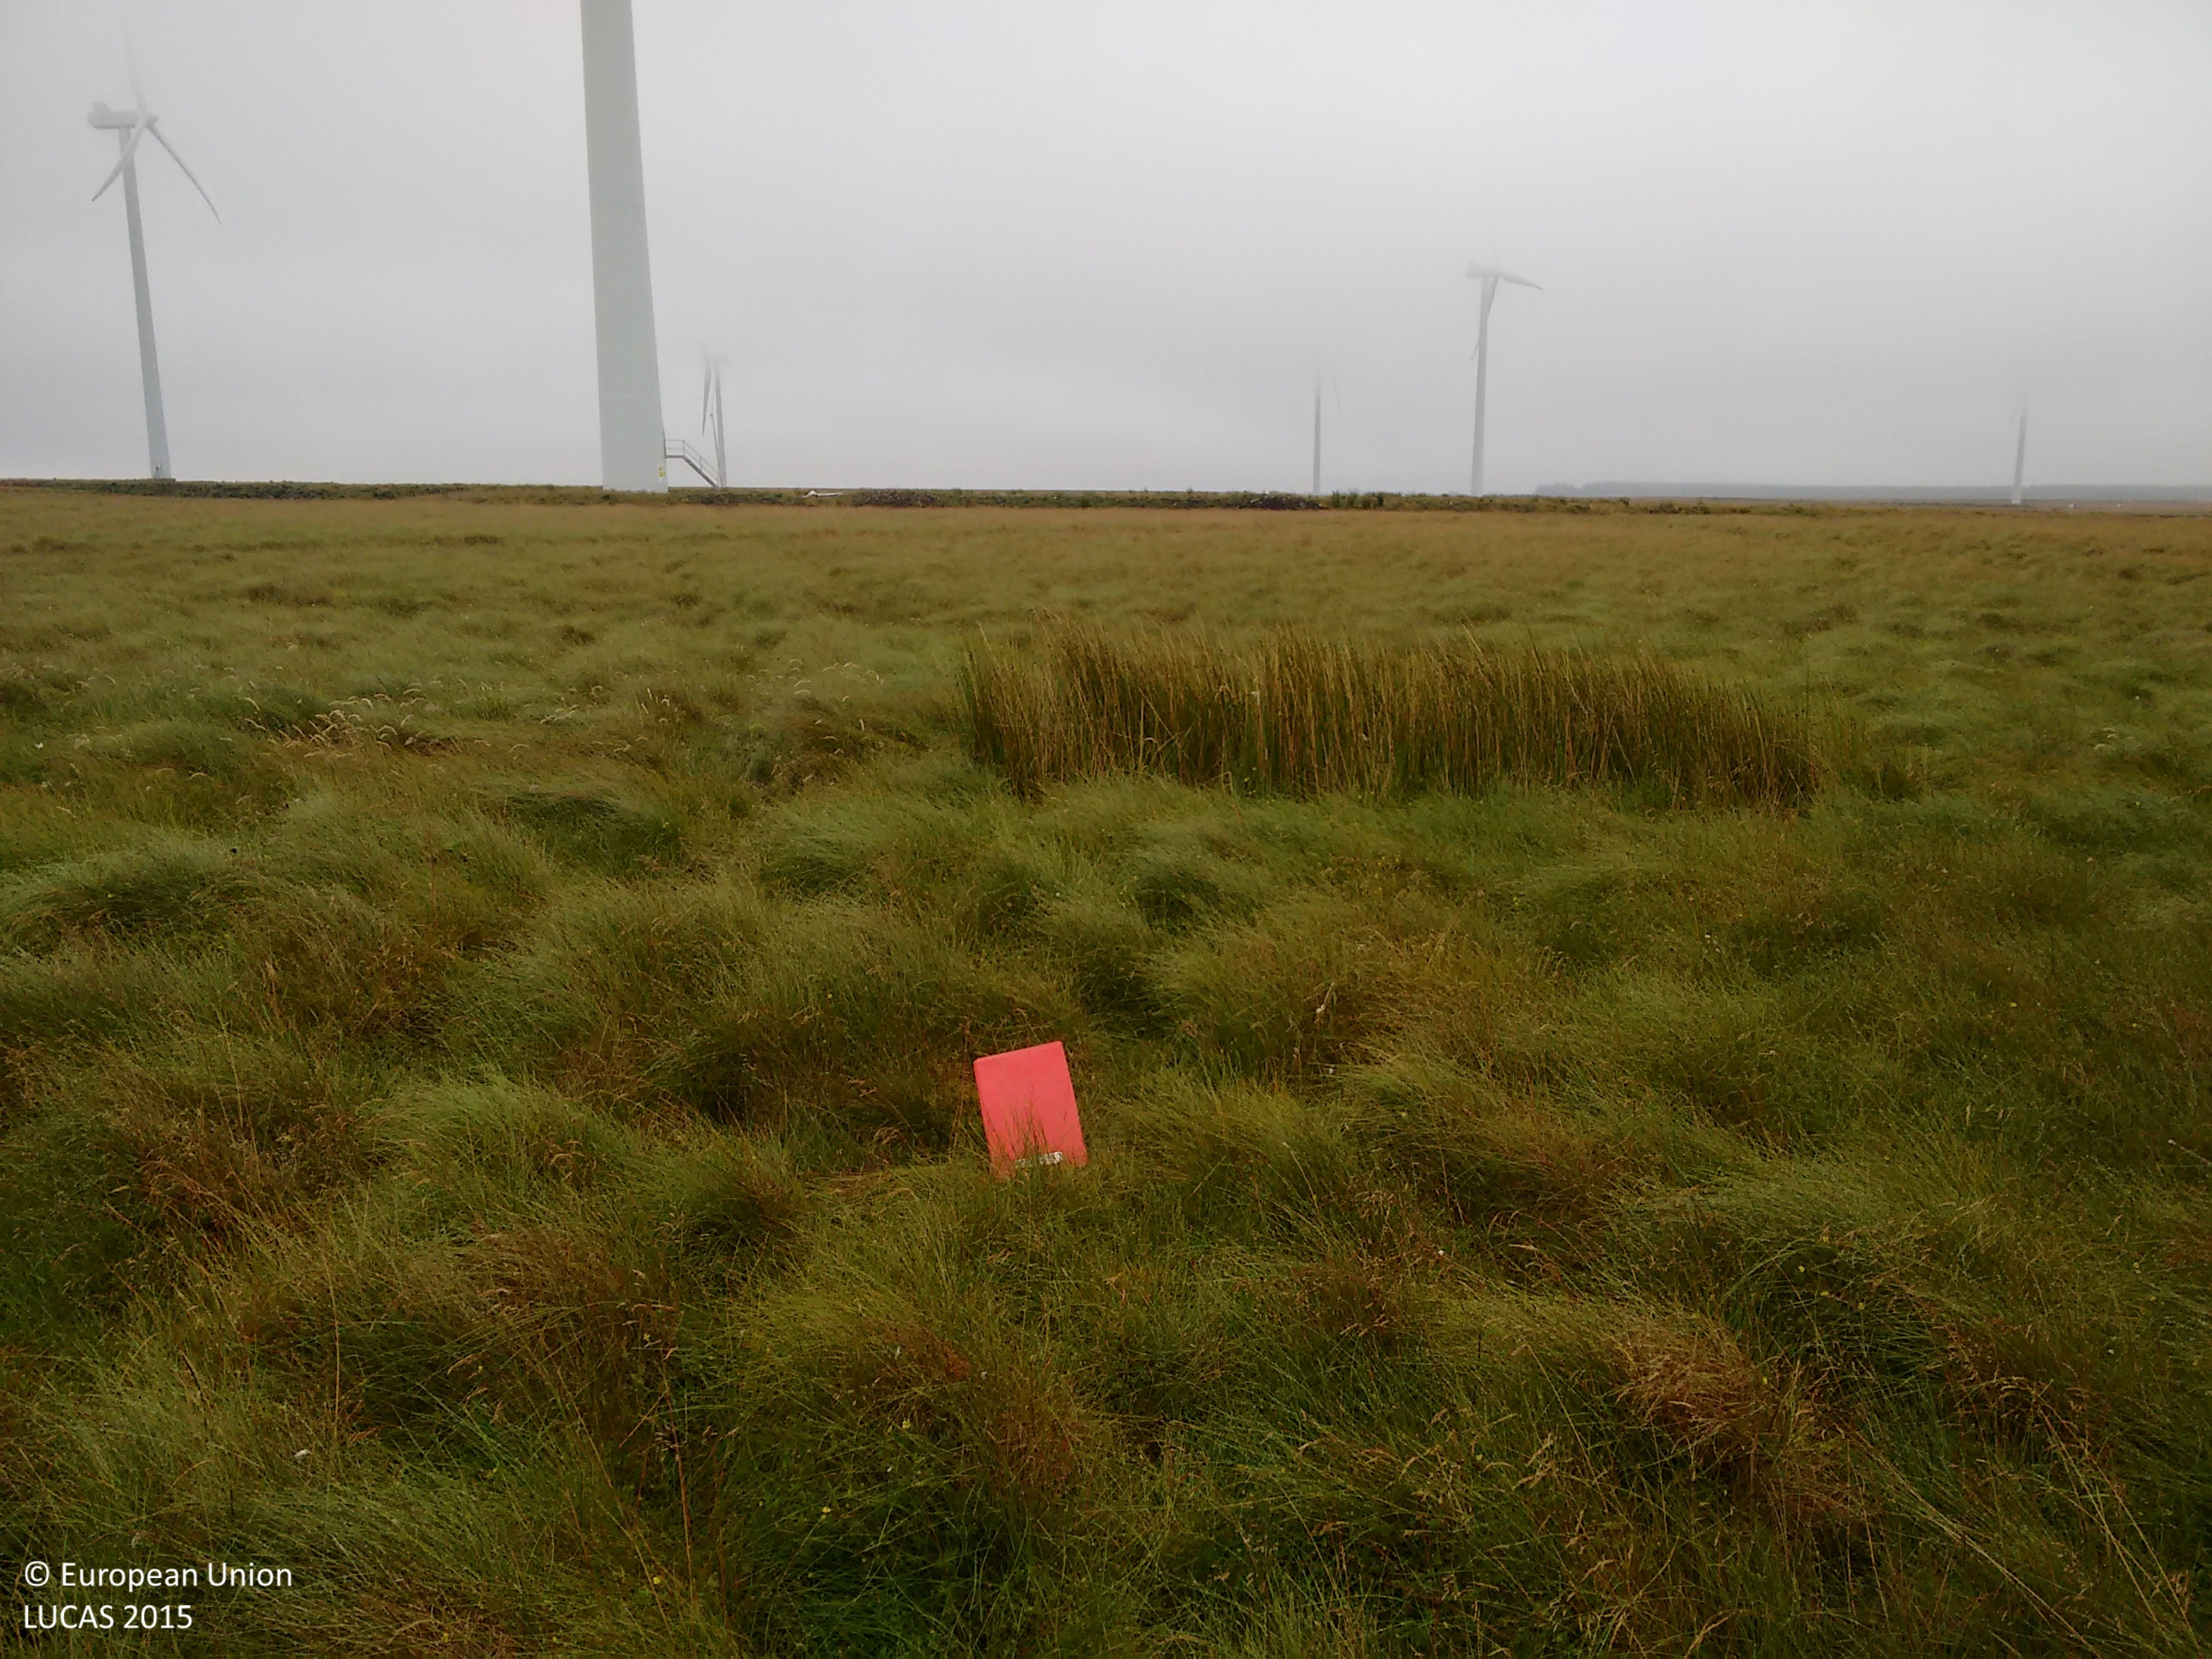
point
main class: Grassland
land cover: Grassland without tree/shrub cover
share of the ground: > 75 %
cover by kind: herbaceous plants 100 %
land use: Energy production
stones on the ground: < 10 %
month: August
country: GB
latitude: 58.4141
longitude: -3.2931
